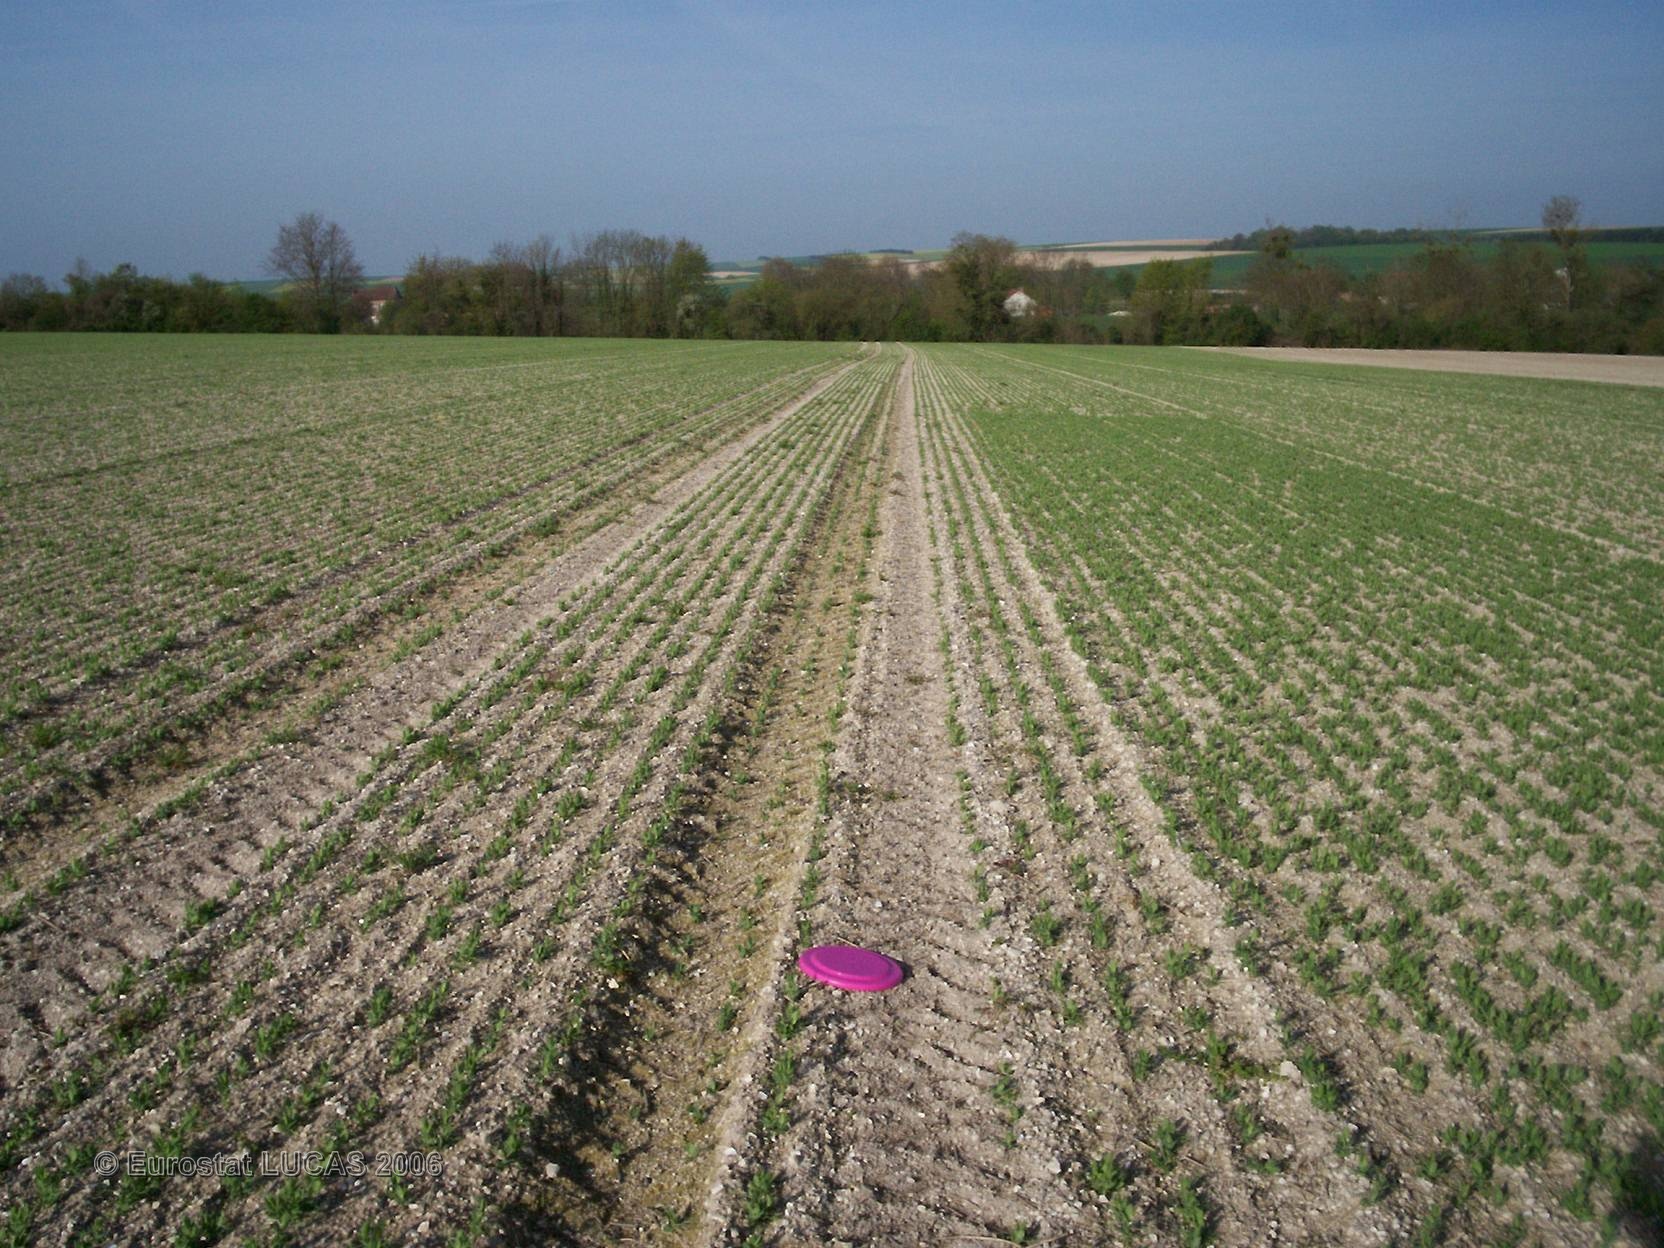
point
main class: Cropland
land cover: Dry pulses
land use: Agriculture (excluding fallow land and kitchen gardens)
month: May
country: FR
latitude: 48.7848
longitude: 4.4028
